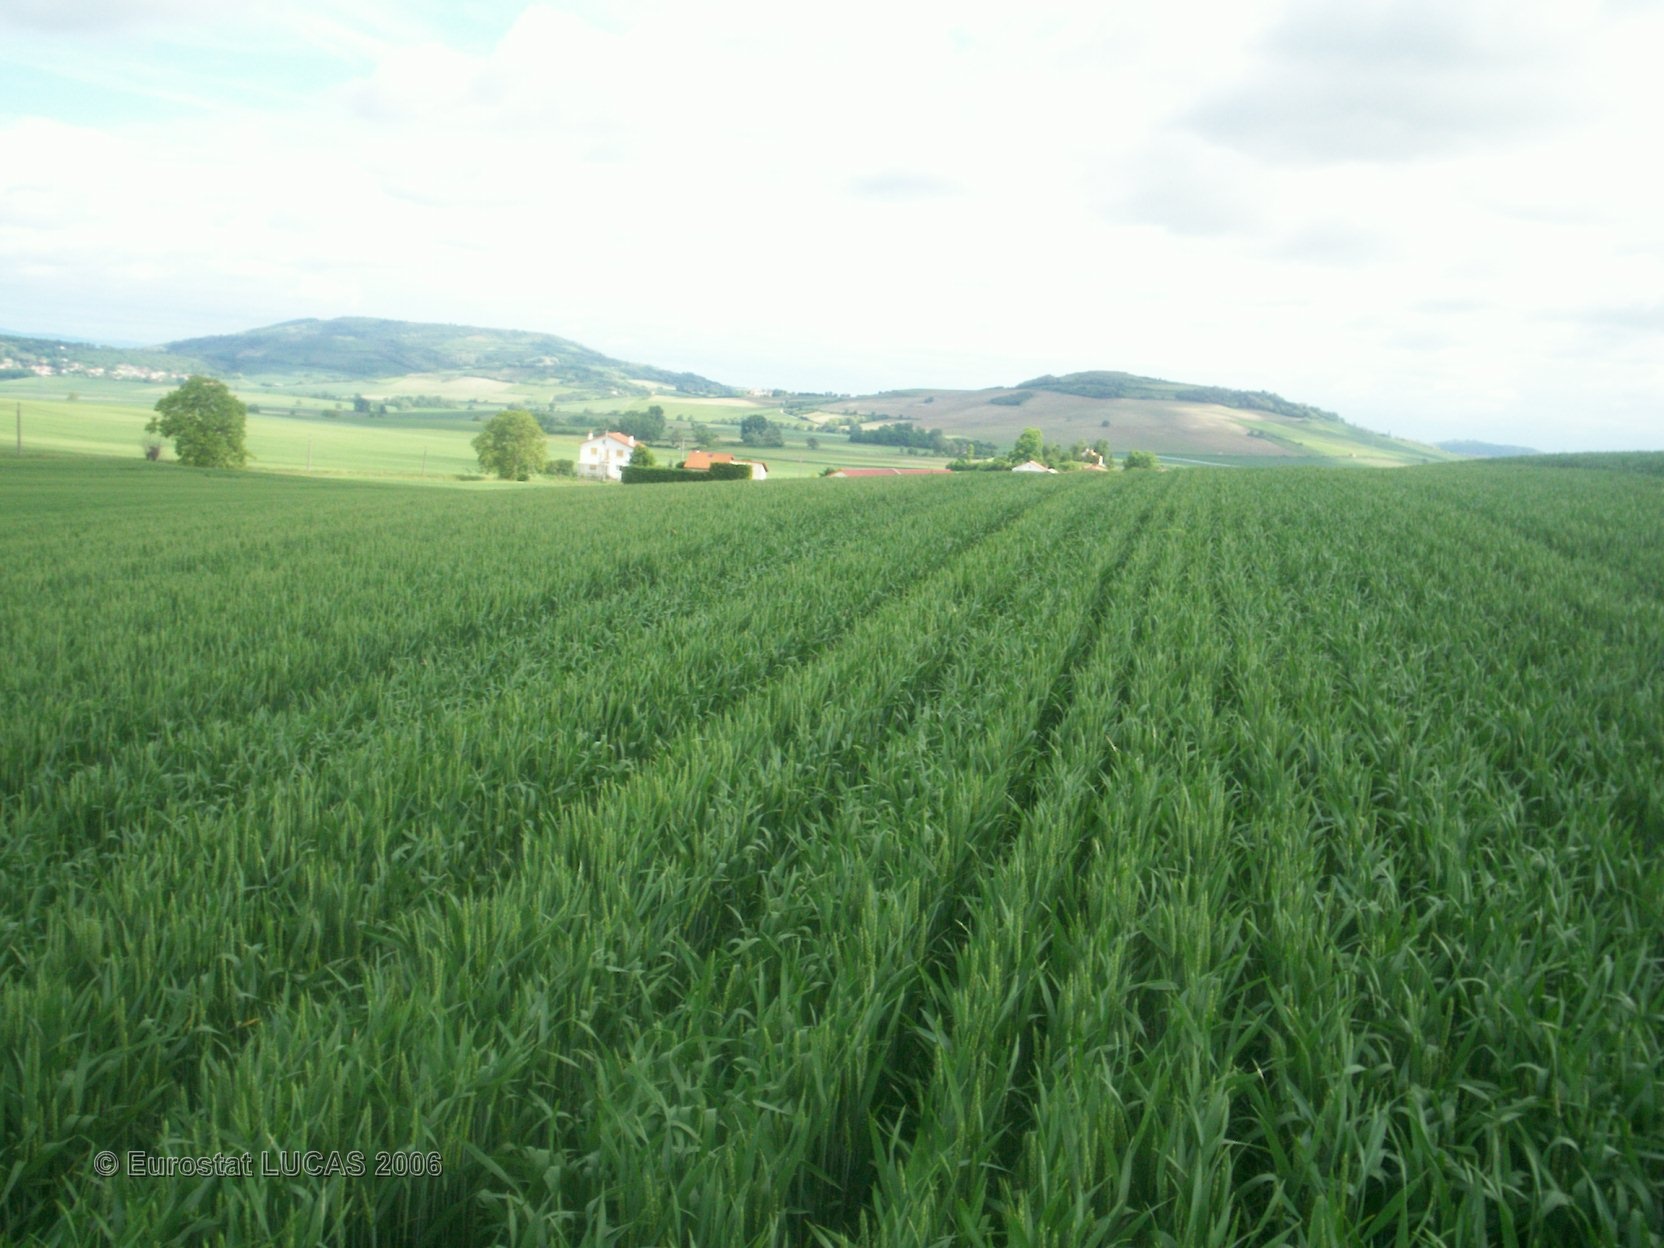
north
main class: Cropland
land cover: Common wheat
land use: Agriculture (excluding fallow land and kitchen gardens)
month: May
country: FR
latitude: 45.7062
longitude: 3.2828
